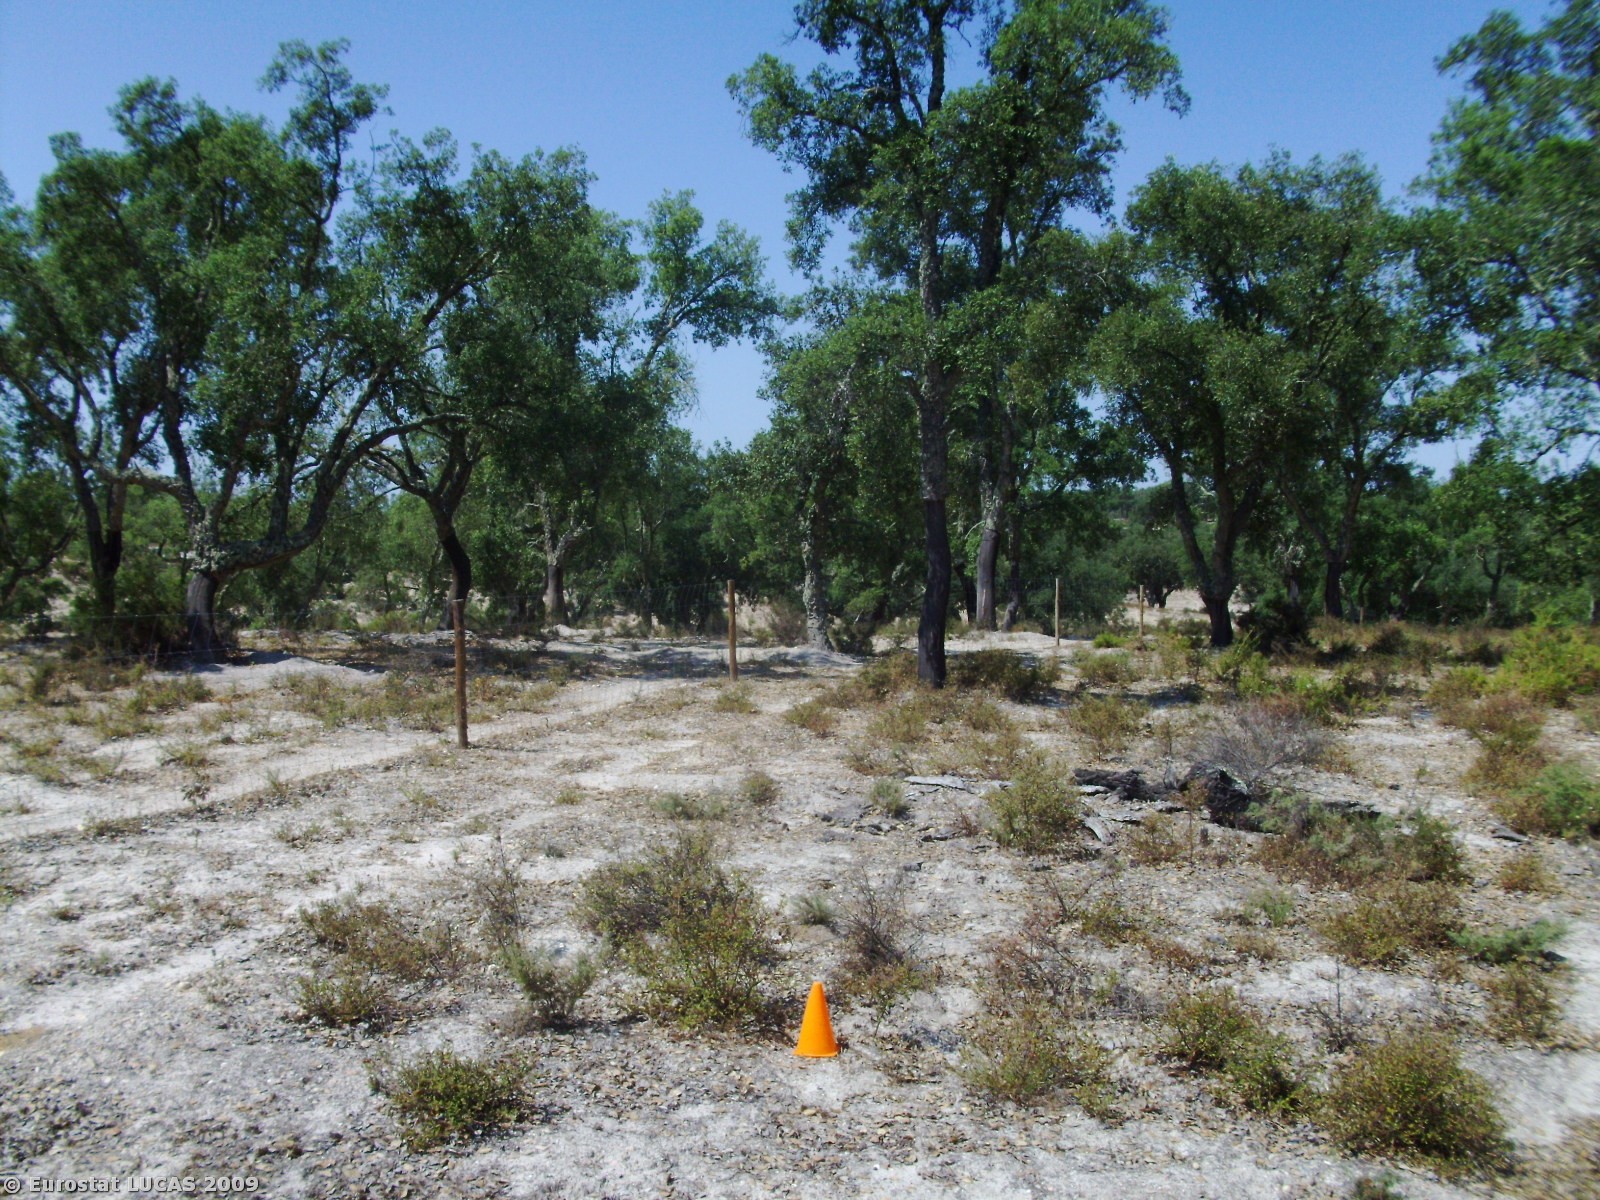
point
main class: Woodland
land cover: Broadleaved woodland
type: broadleaved evergreen forest
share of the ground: 25 - 50 %
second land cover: Bare land
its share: 25 - 50 %
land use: Forestry
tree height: > 5 m
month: August
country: PT
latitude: 39.2563
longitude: -8.0770
